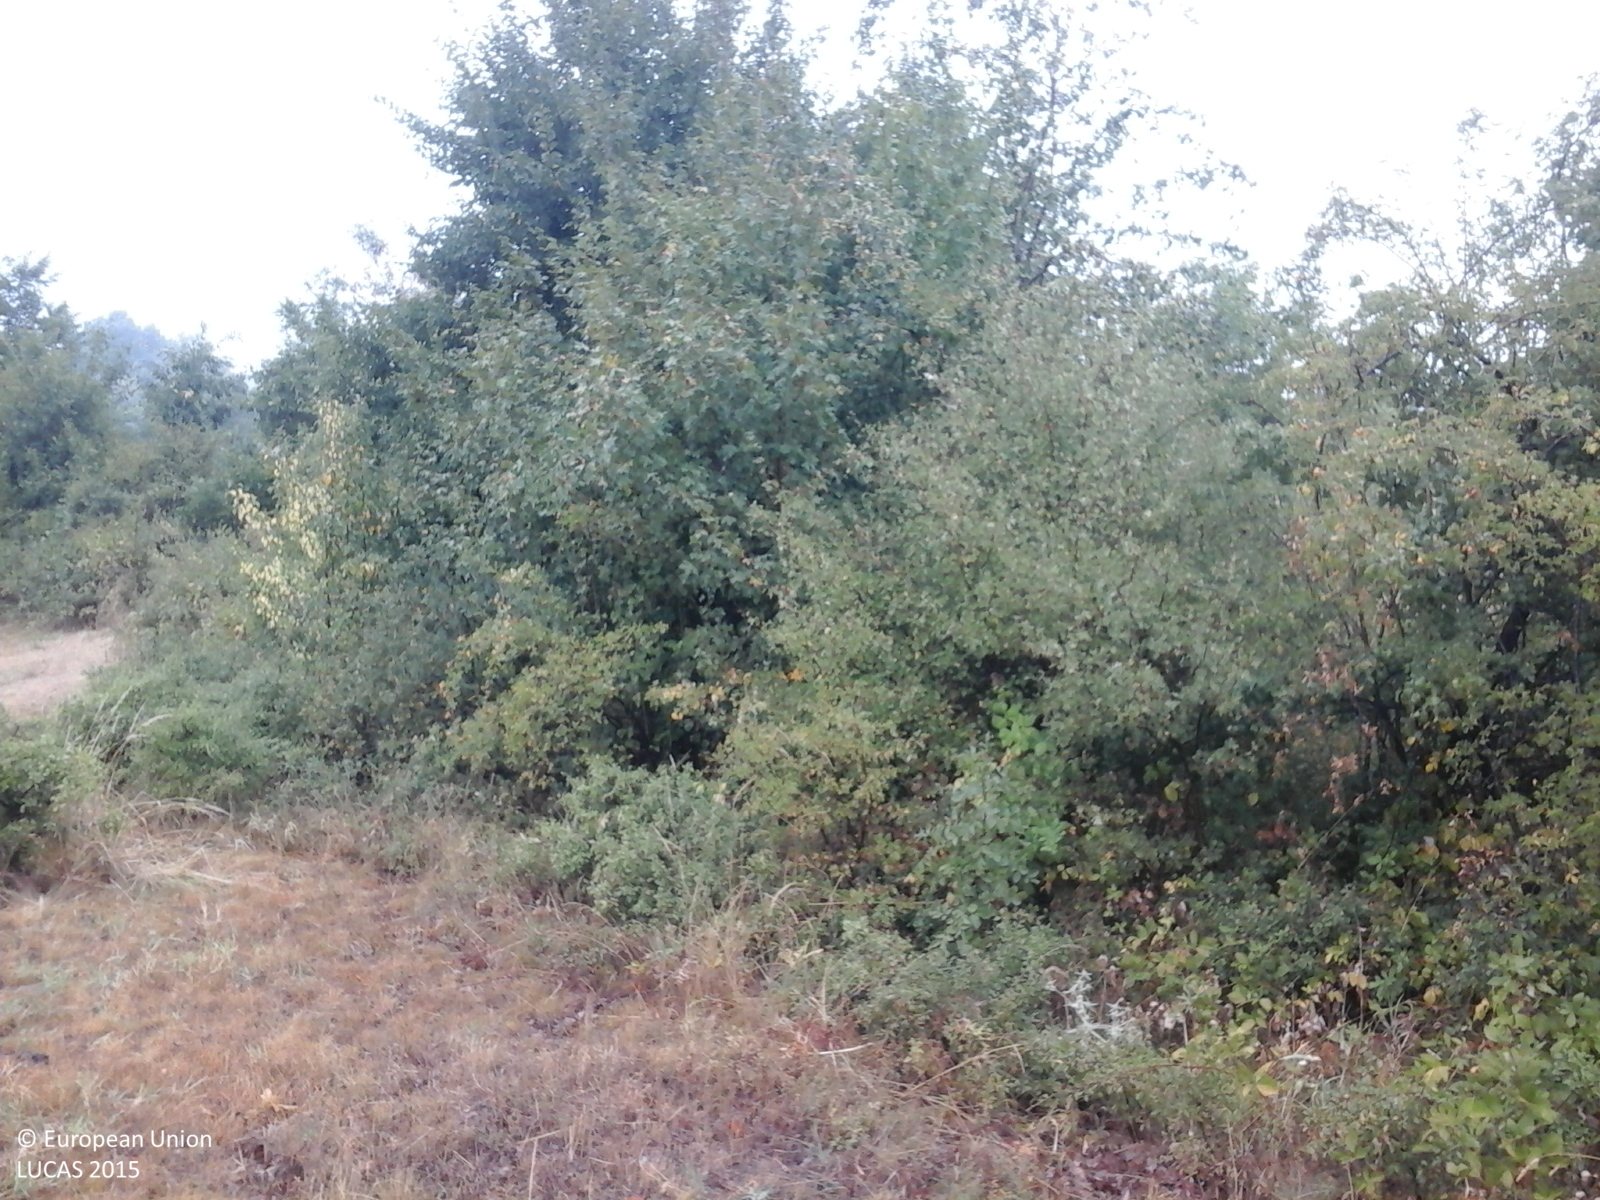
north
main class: Grassland
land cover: Grassland without tree/shrub cover
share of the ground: > 75 %
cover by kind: herbaceous plants 100 %
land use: Agriculture (excluding fallow land and kitchen gardens)
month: August
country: RO
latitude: 44.7891
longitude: 22.6955
